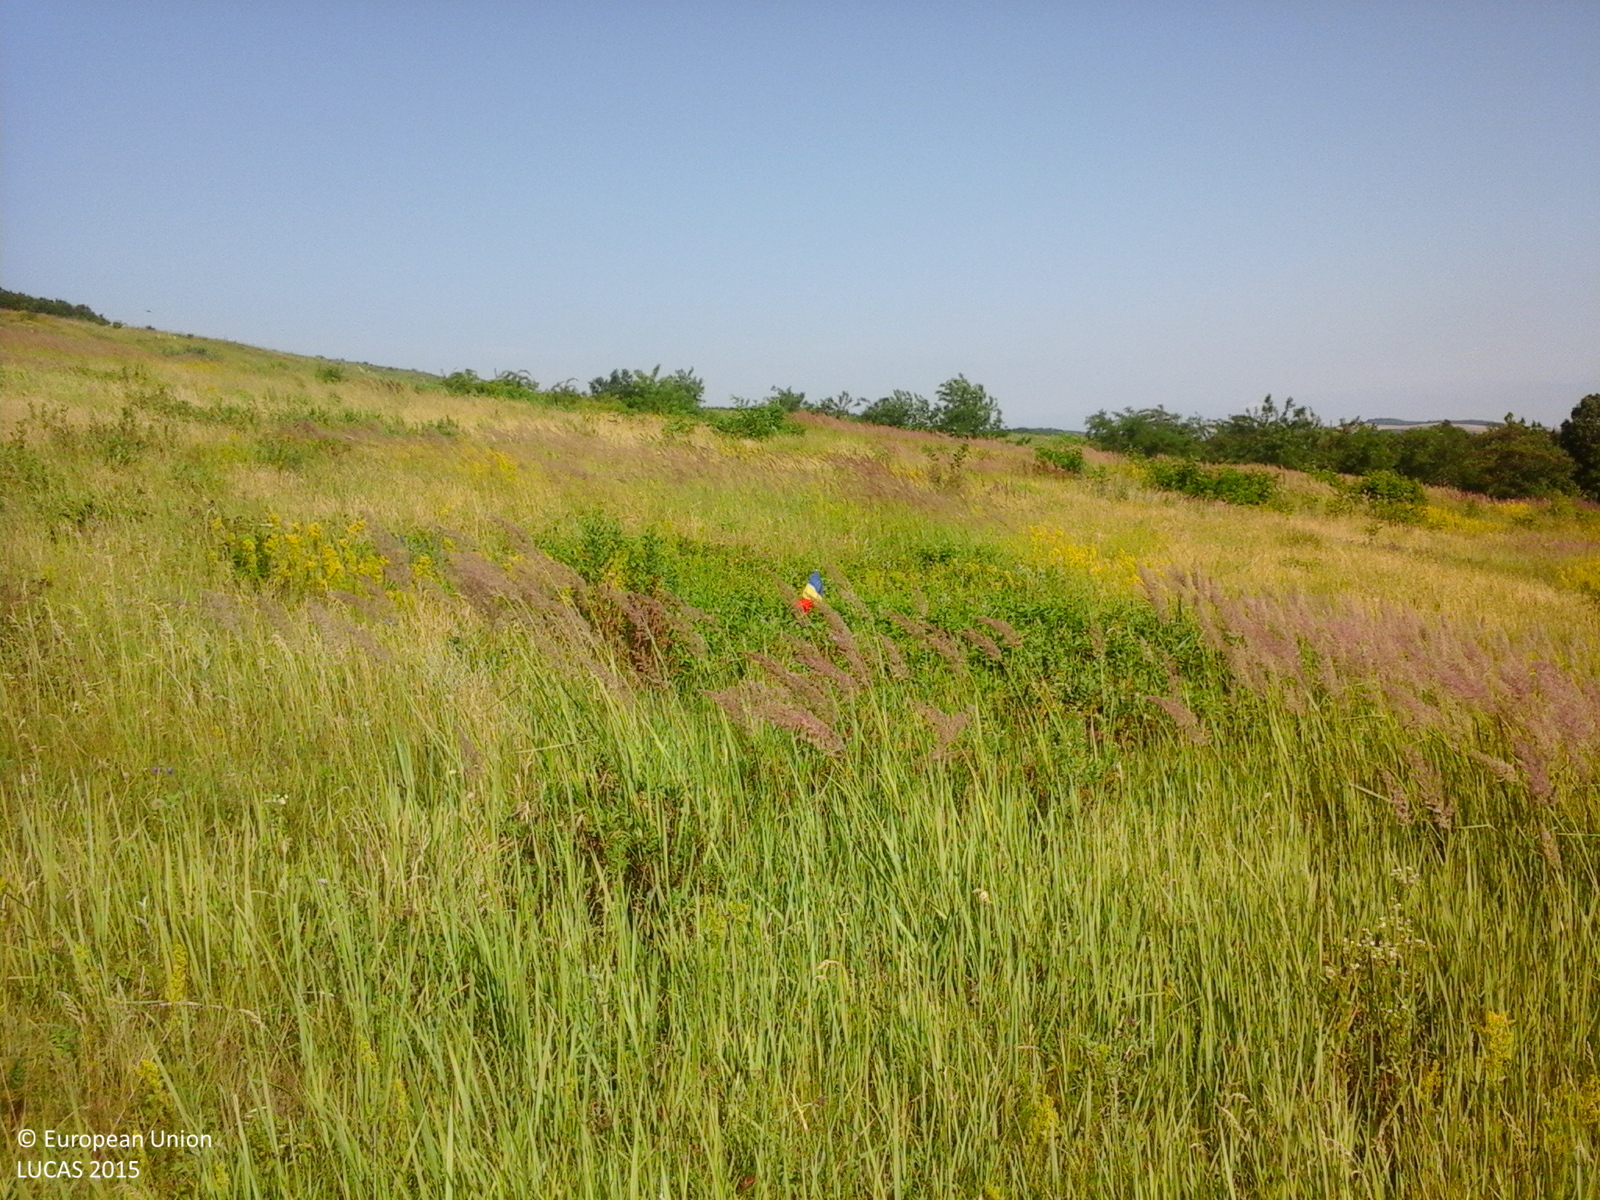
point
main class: Grassland
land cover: Grassland with sparse tree/shrub cover
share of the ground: > 75 %
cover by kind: herbaceous plants 85 %, shrubs 10 %, broadleaved forest trees 5 %
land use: Fallow land
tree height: < 5 m
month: June
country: RO
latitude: 46.6425
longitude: 27.3927
